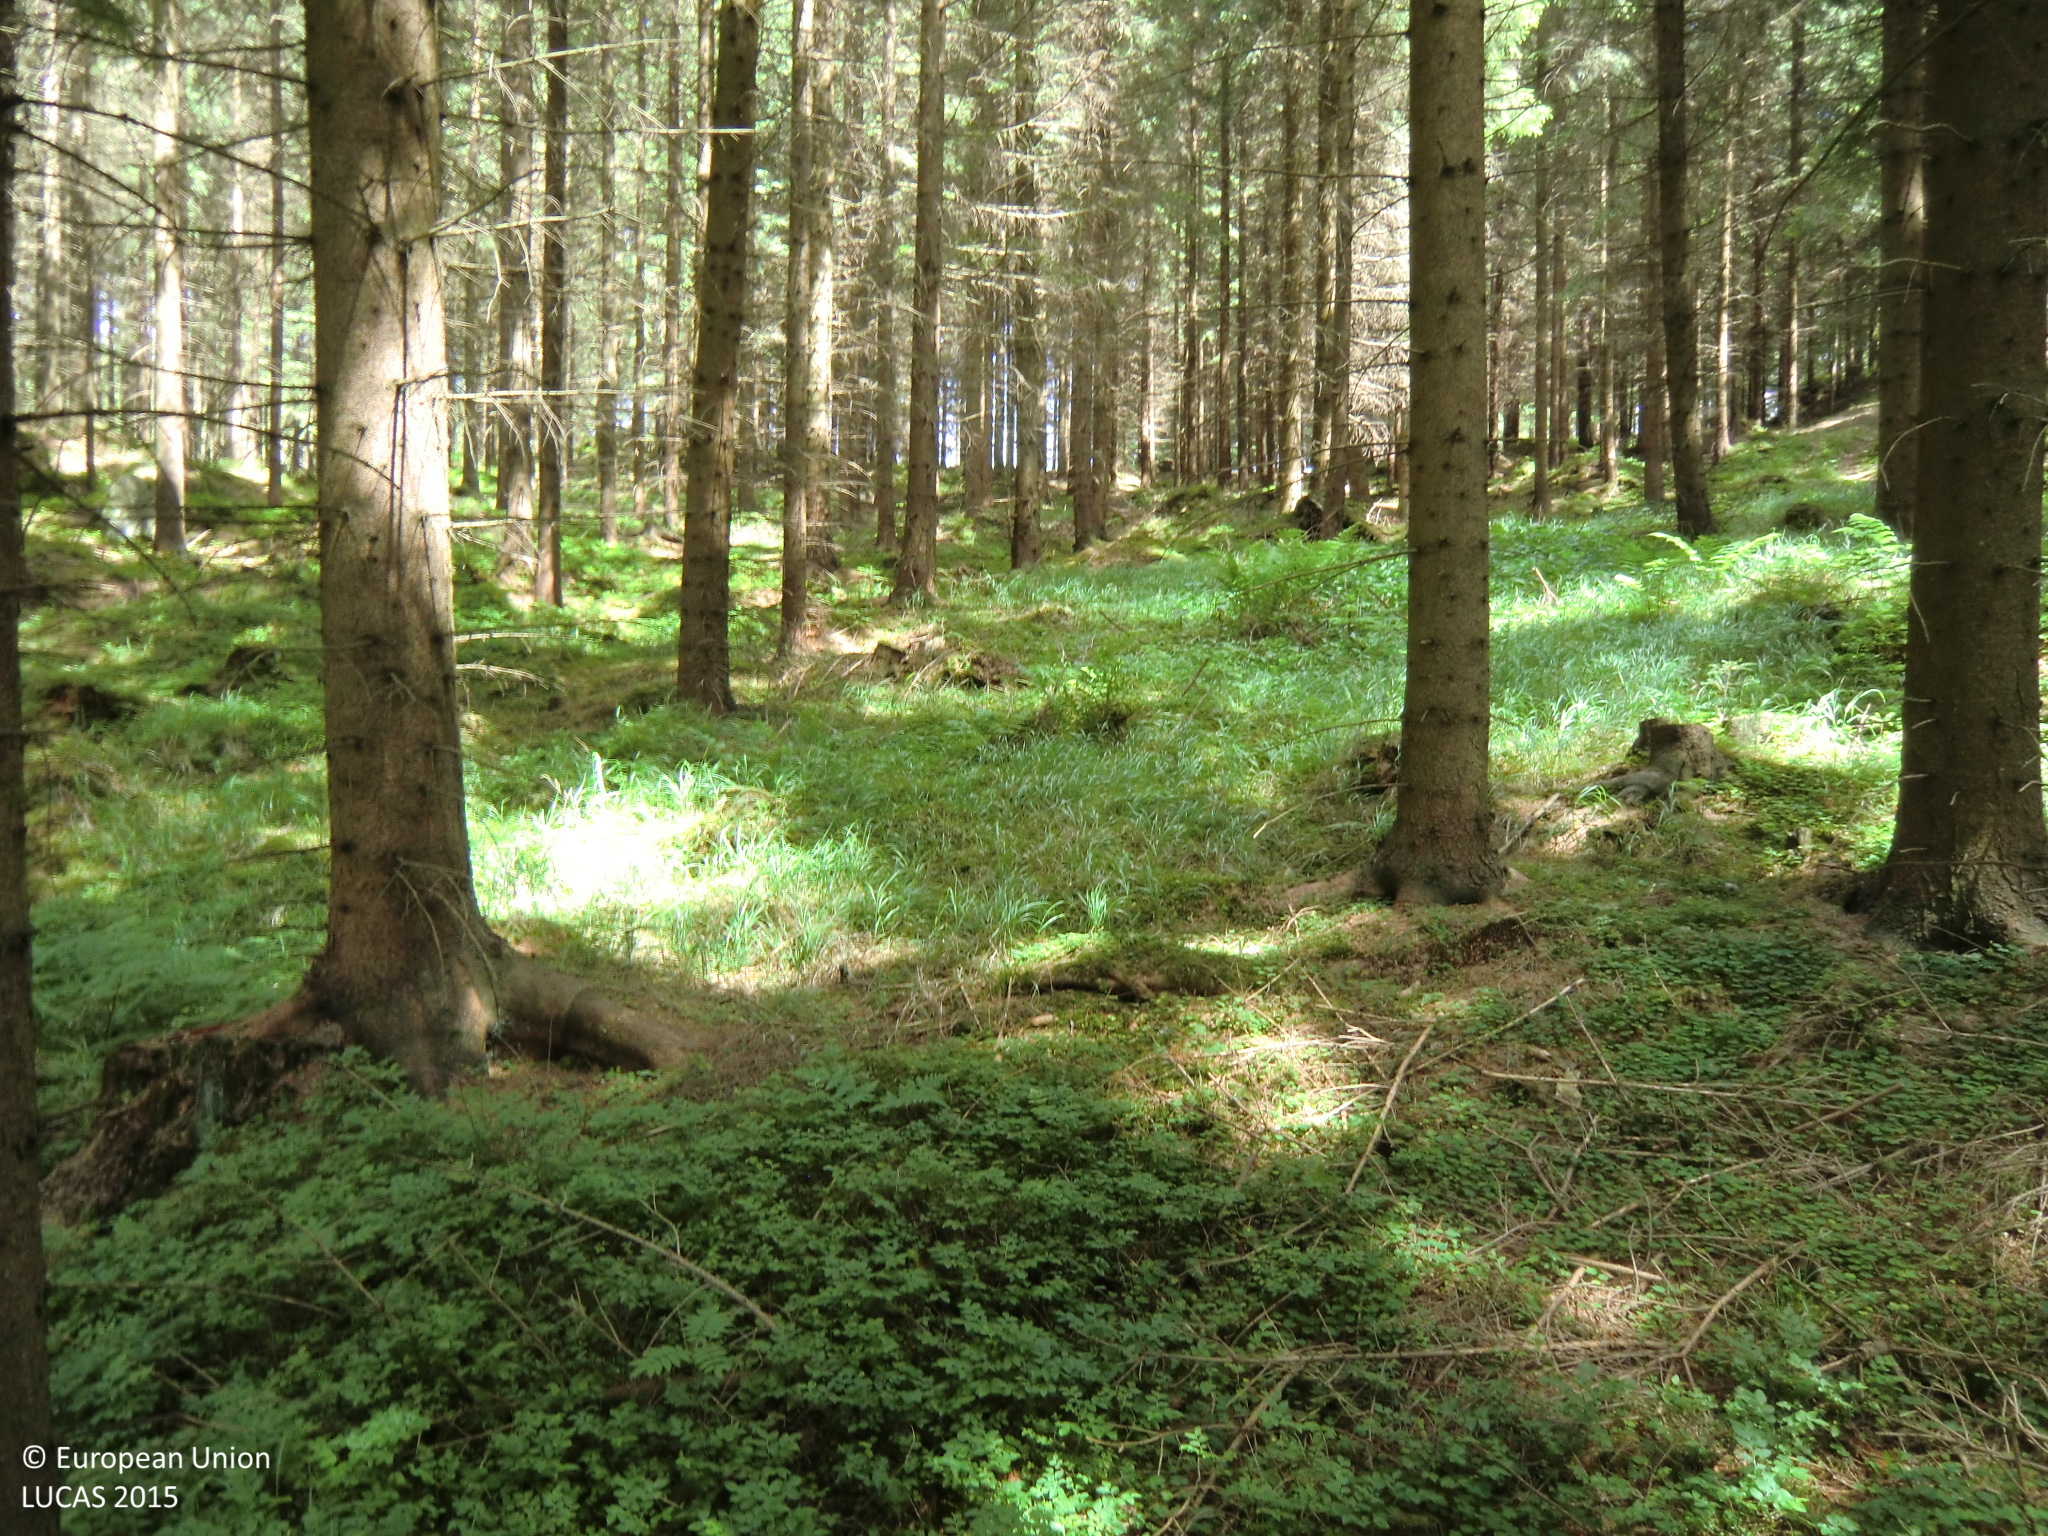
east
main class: Woodland
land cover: Spruce dominated coniferous woodland
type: hemiboreal forest and nemoral coniferous forest and mixed broadleaved-coniferous forest
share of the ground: > 75 %
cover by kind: coniferous forest trees 80 %, shrubs 10 %, herbaceous plants 10 %
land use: Forestry
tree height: > 5 m
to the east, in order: Spruce dominated coniferous woodland; Tracks; Spruce dominated coniferous woodland; Tracks; Spruce dominated coniferous woodland; Grass margins; Paved roads, cycling and walking lanes; Grassland without tree/shrub cover; Temporary grasslands
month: June
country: AT
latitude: 48.5309
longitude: 14.8629
